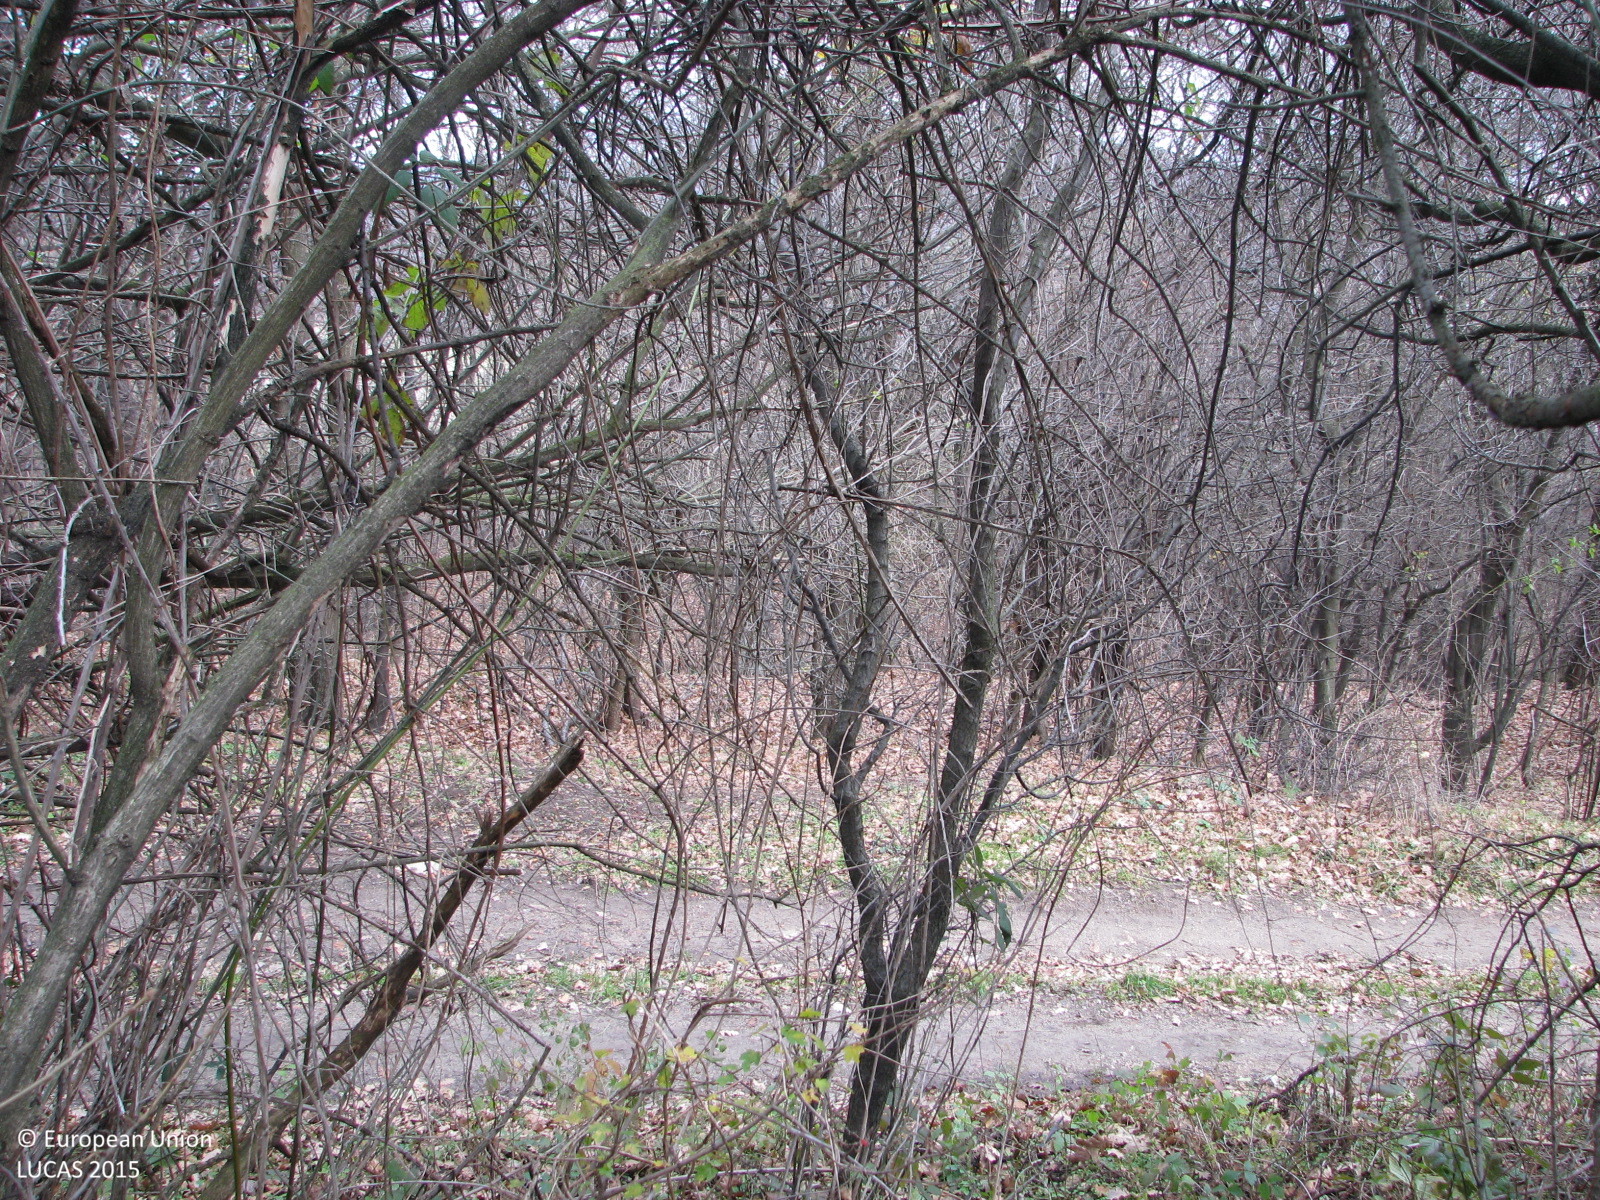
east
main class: Woodland
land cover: Broadleaved woodland
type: mesophytic deciduous forest
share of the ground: > 75 %
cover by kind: broadleaved forest trees 80 %, herbaceous plants 10 %, unconsolidated bare surface 10 %
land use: Semi-natural and natural areas not in use
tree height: < 5 m
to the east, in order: Tracks; Broadleaved woodland; Rivers and streams; Broadleaved woodland; Spontaneously vegetated surfaces; Shrubland with sparse tree cover; Grassland without tree/shrub cover; Artificial constructions in urban areas
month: December
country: BG
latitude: 42.5470
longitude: 24.1844
